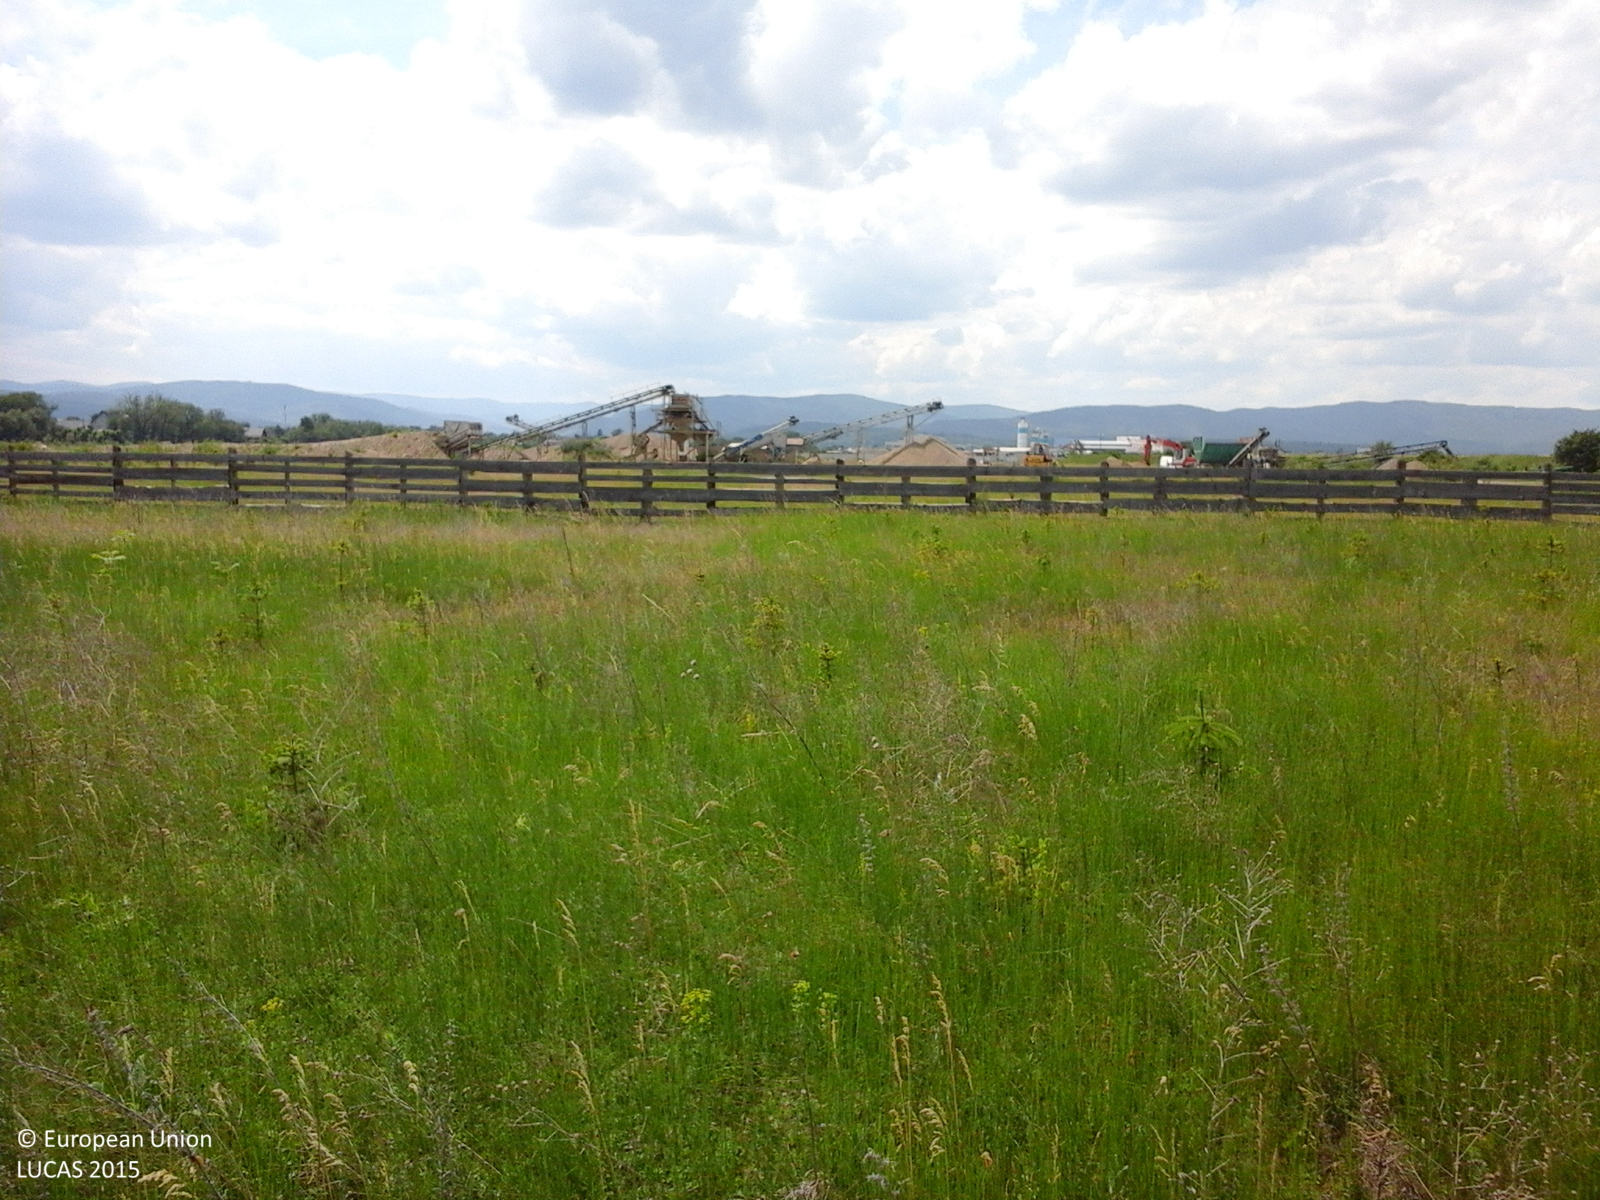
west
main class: Grassland
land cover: Spontaneously vegetated surfaces
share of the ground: > 75 %
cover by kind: herbaceous plants 100 %
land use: Fallow land
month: June
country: RO
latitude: 47.8194
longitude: 25.8472
